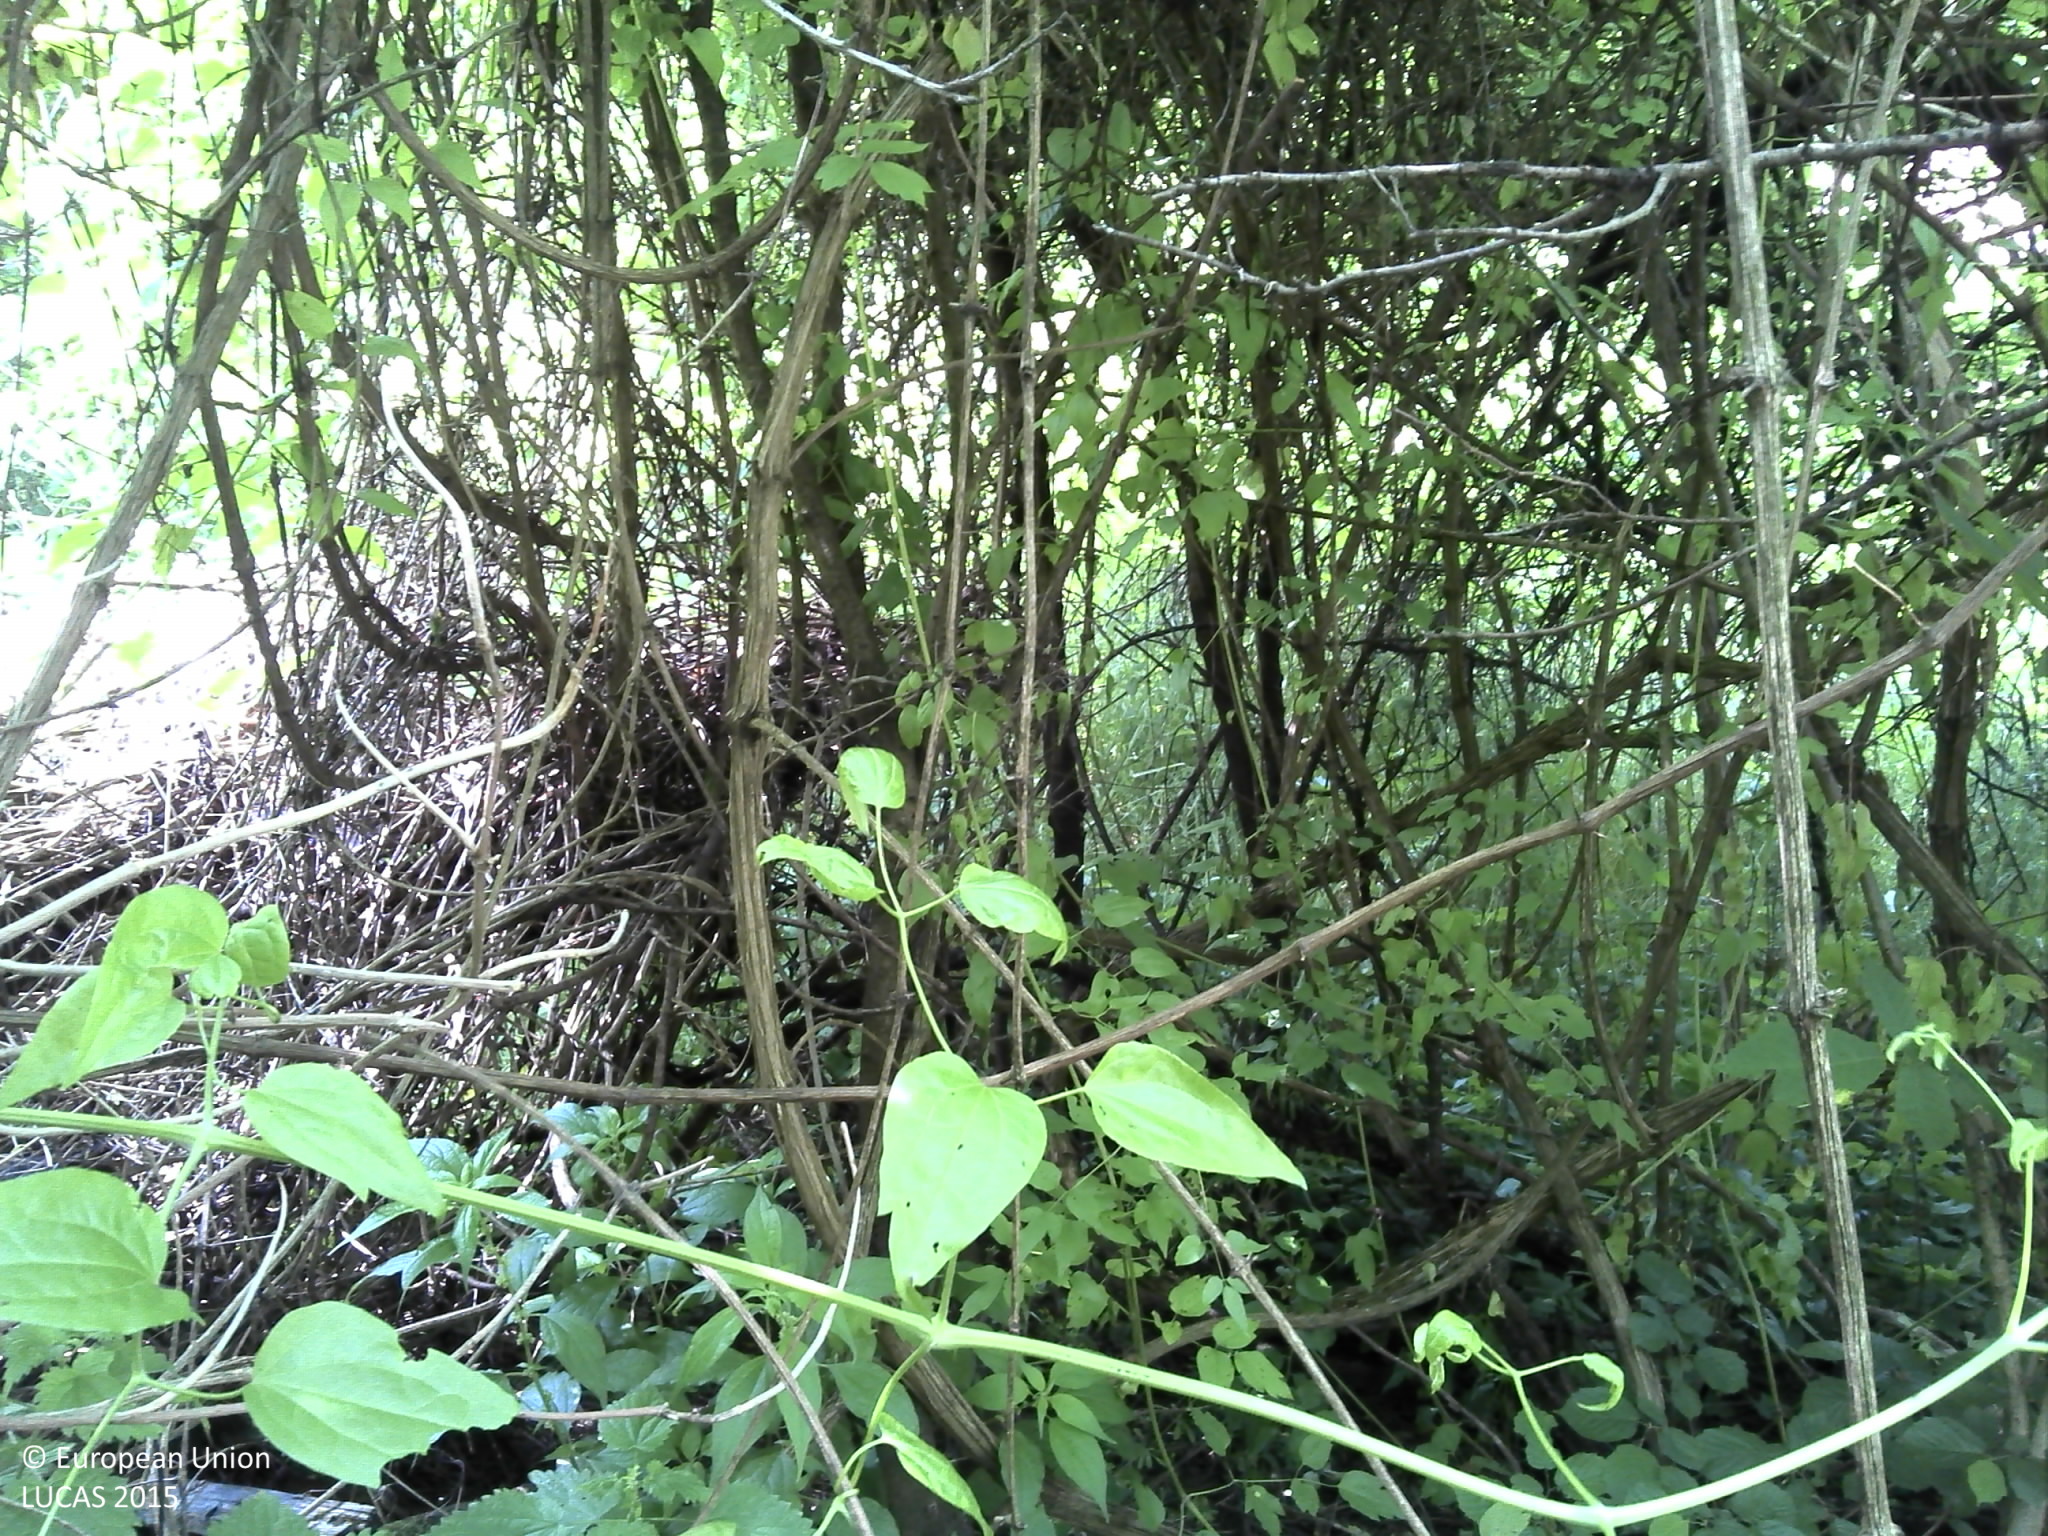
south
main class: Shrubland
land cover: Shrubland with sparse tree cover
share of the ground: > 75 %
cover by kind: shrubs 95 %, broadleaved forest trees 5 %
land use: Semi-natural and natural areas not in use
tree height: < 5 m
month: May
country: HR
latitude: 45.3187
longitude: 17.8733
